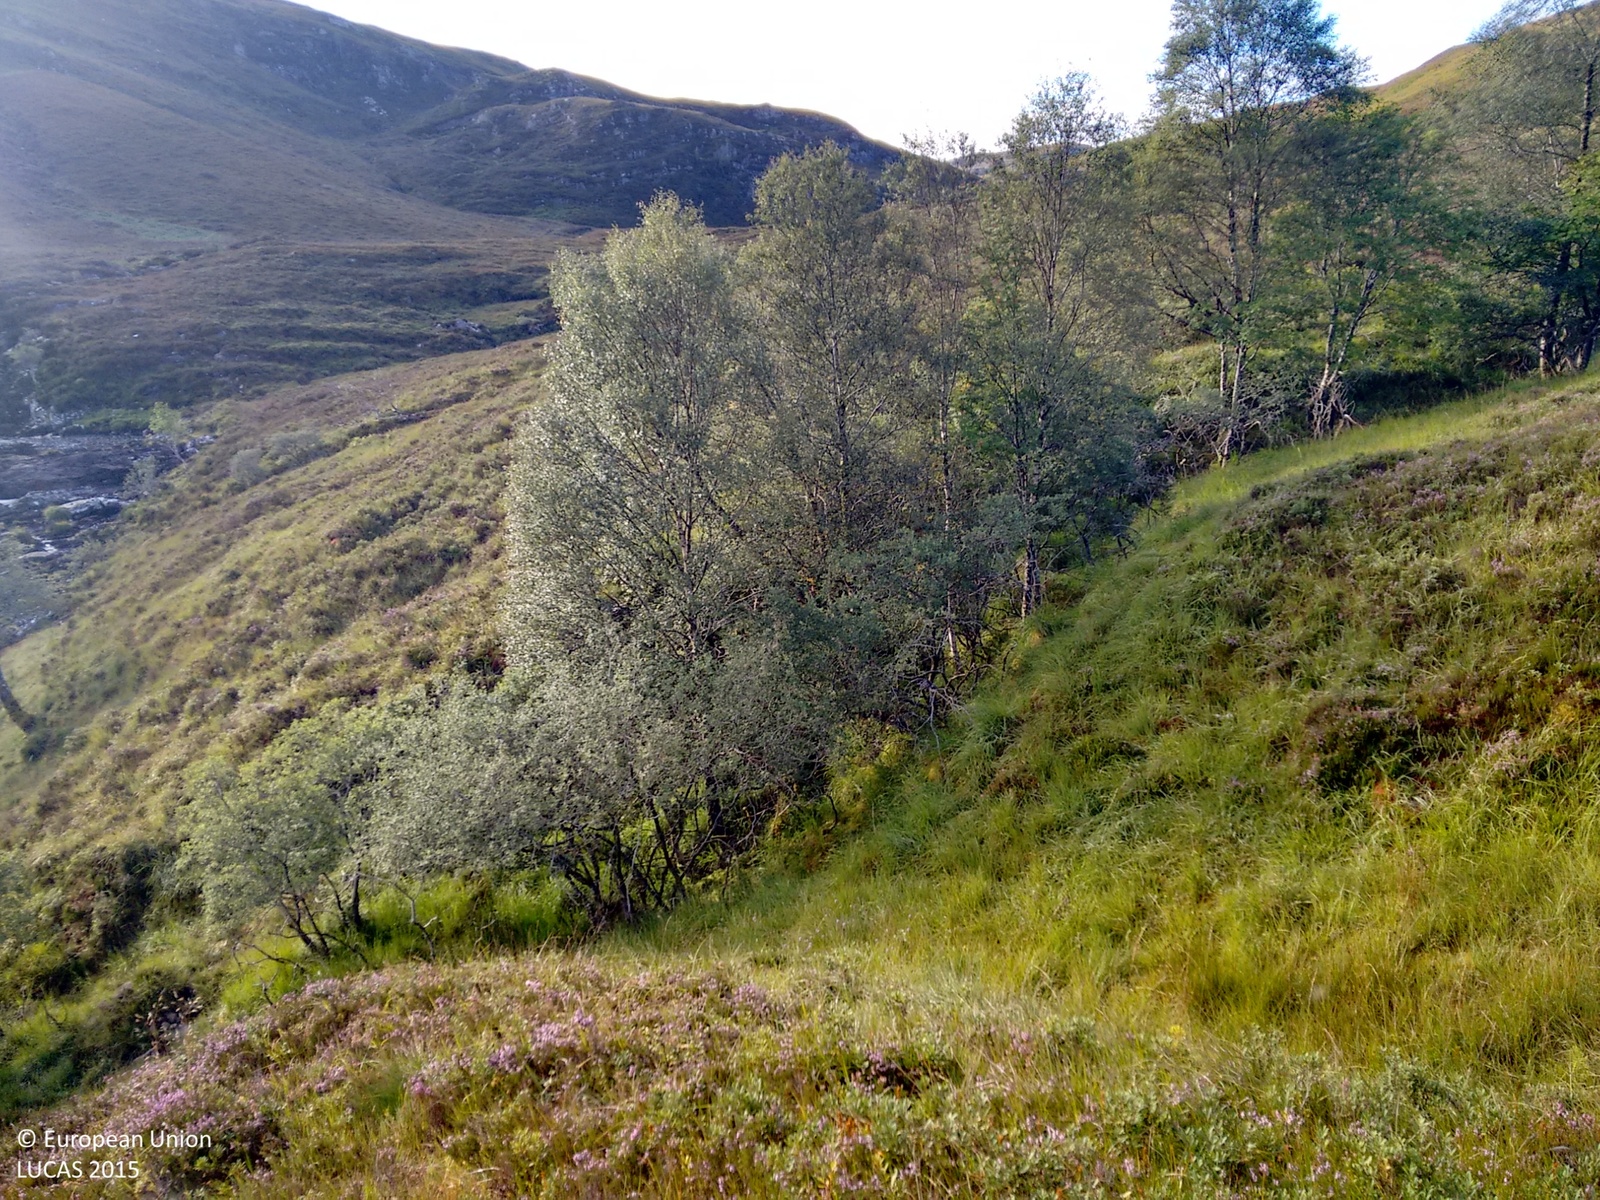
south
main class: Shrubland
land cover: Shrubland without tree cover
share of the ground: > 75 %
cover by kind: shrubs 90 %, herbaceous plants 10 %
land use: Agriculture (excluding fallow land and kitchen gardens)
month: September
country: GB
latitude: 57.7925
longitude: -5.1605
